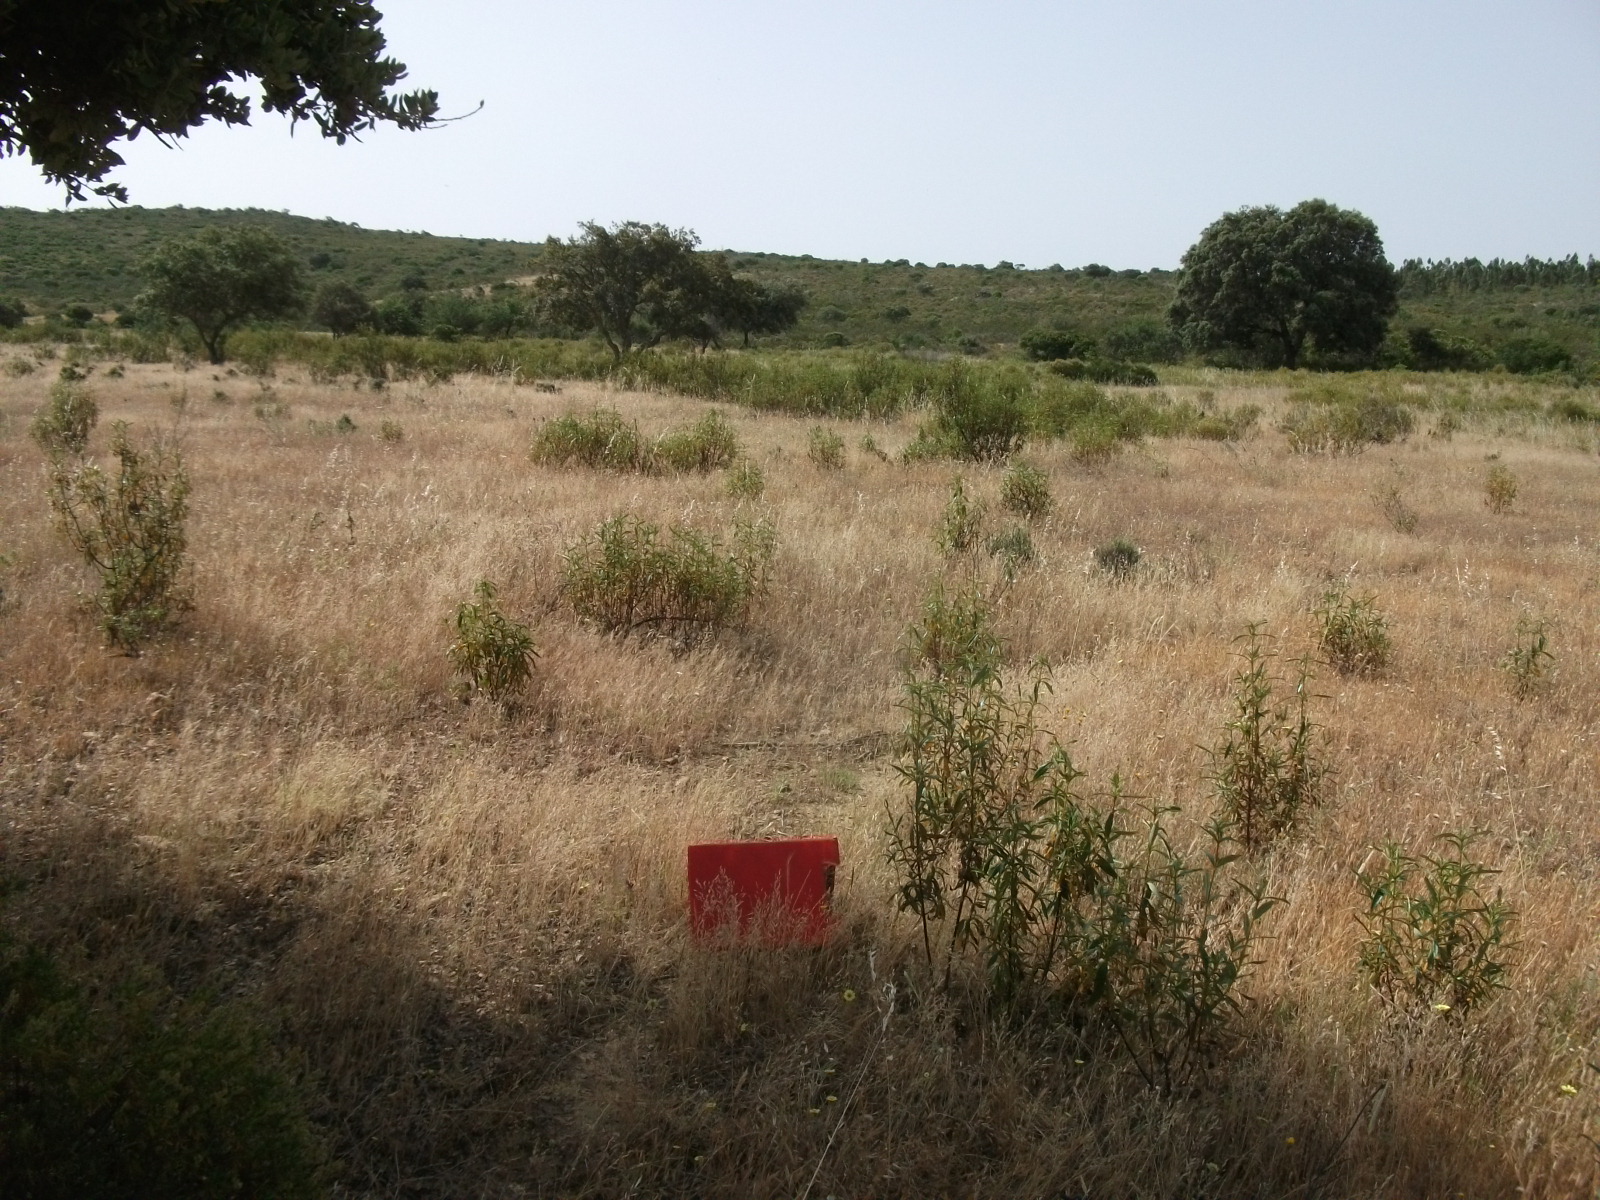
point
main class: Grassland
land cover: Grassland with sparse tree/shrub cover
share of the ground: > 75 %
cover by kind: herbaceous plants 90 %, broadleaved forest trees 5 %, shrubs 5 %
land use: Agriculture (excluding fallow land and kitchen gardens)
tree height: < 5 m
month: May
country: ES
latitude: 37.7492
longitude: -7.0399
